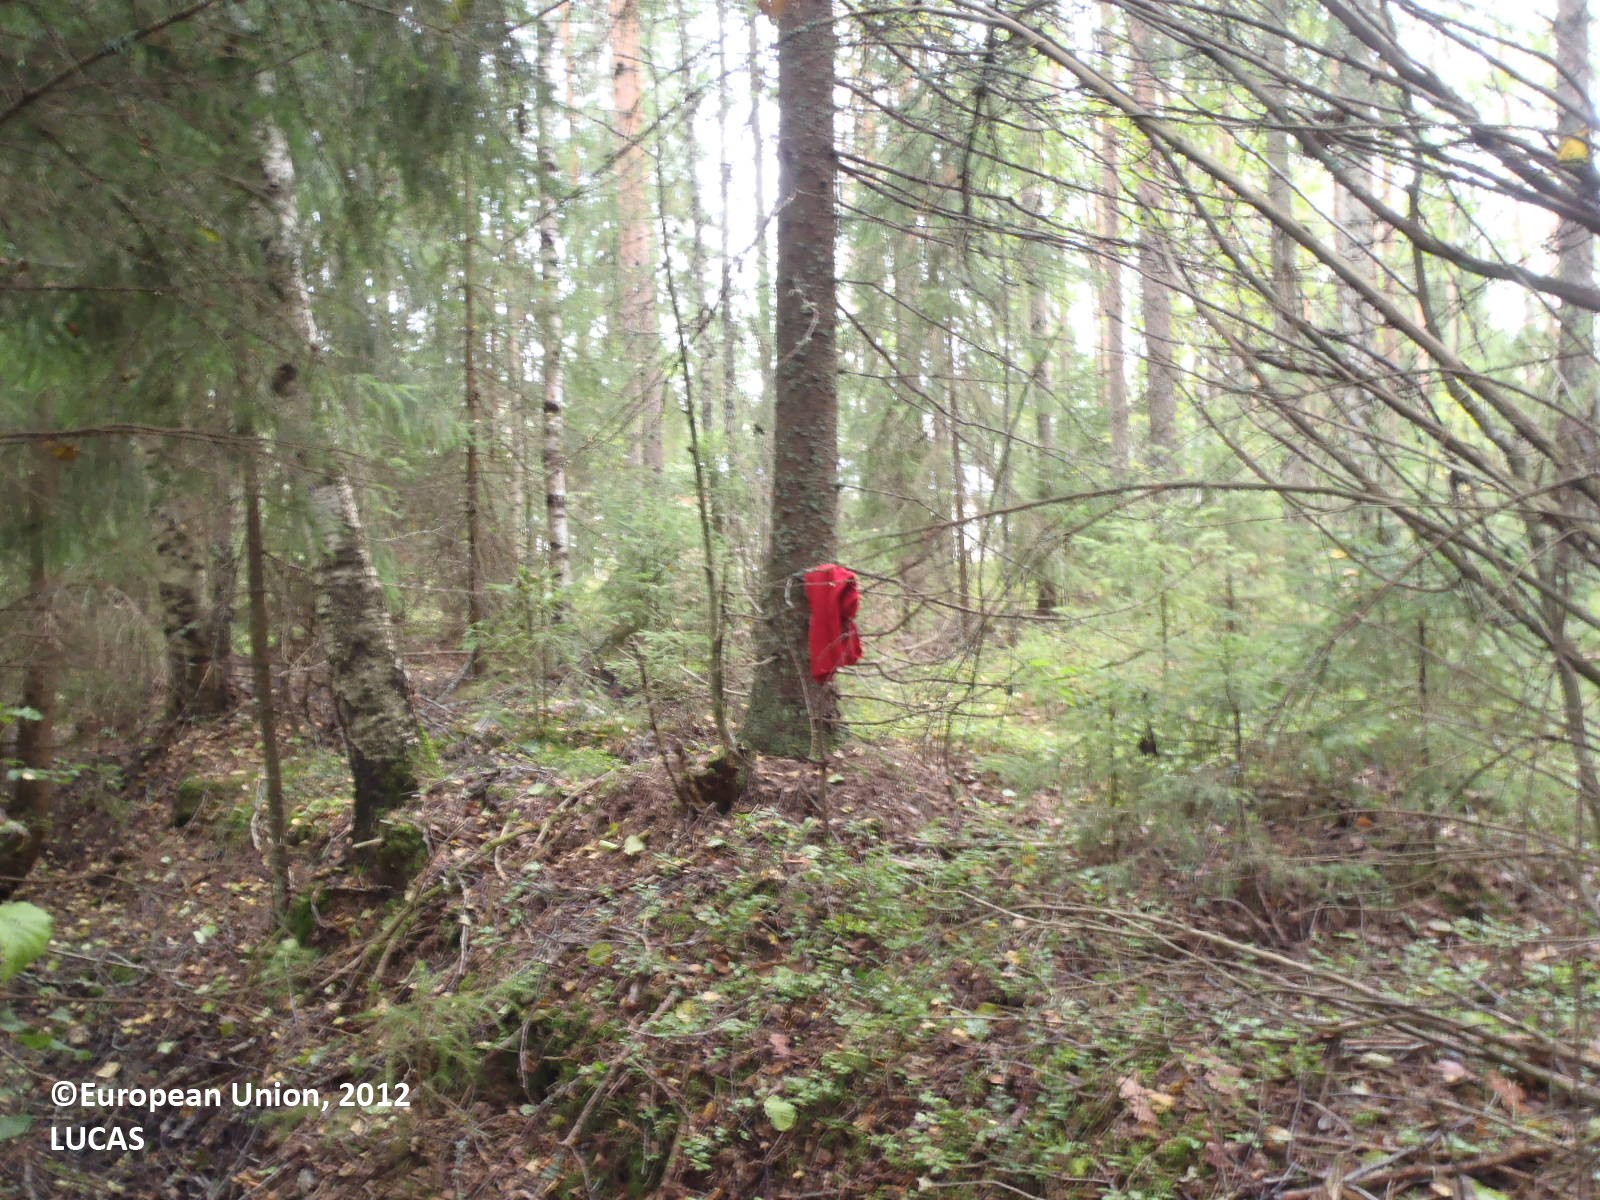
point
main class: Woodland
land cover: Pine dominated mixed woodland
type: boreal forest
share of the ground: > 75 %
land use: Forestry
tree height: > 5 m
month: September
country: FI
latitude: 60.7439
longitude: 22.8223
